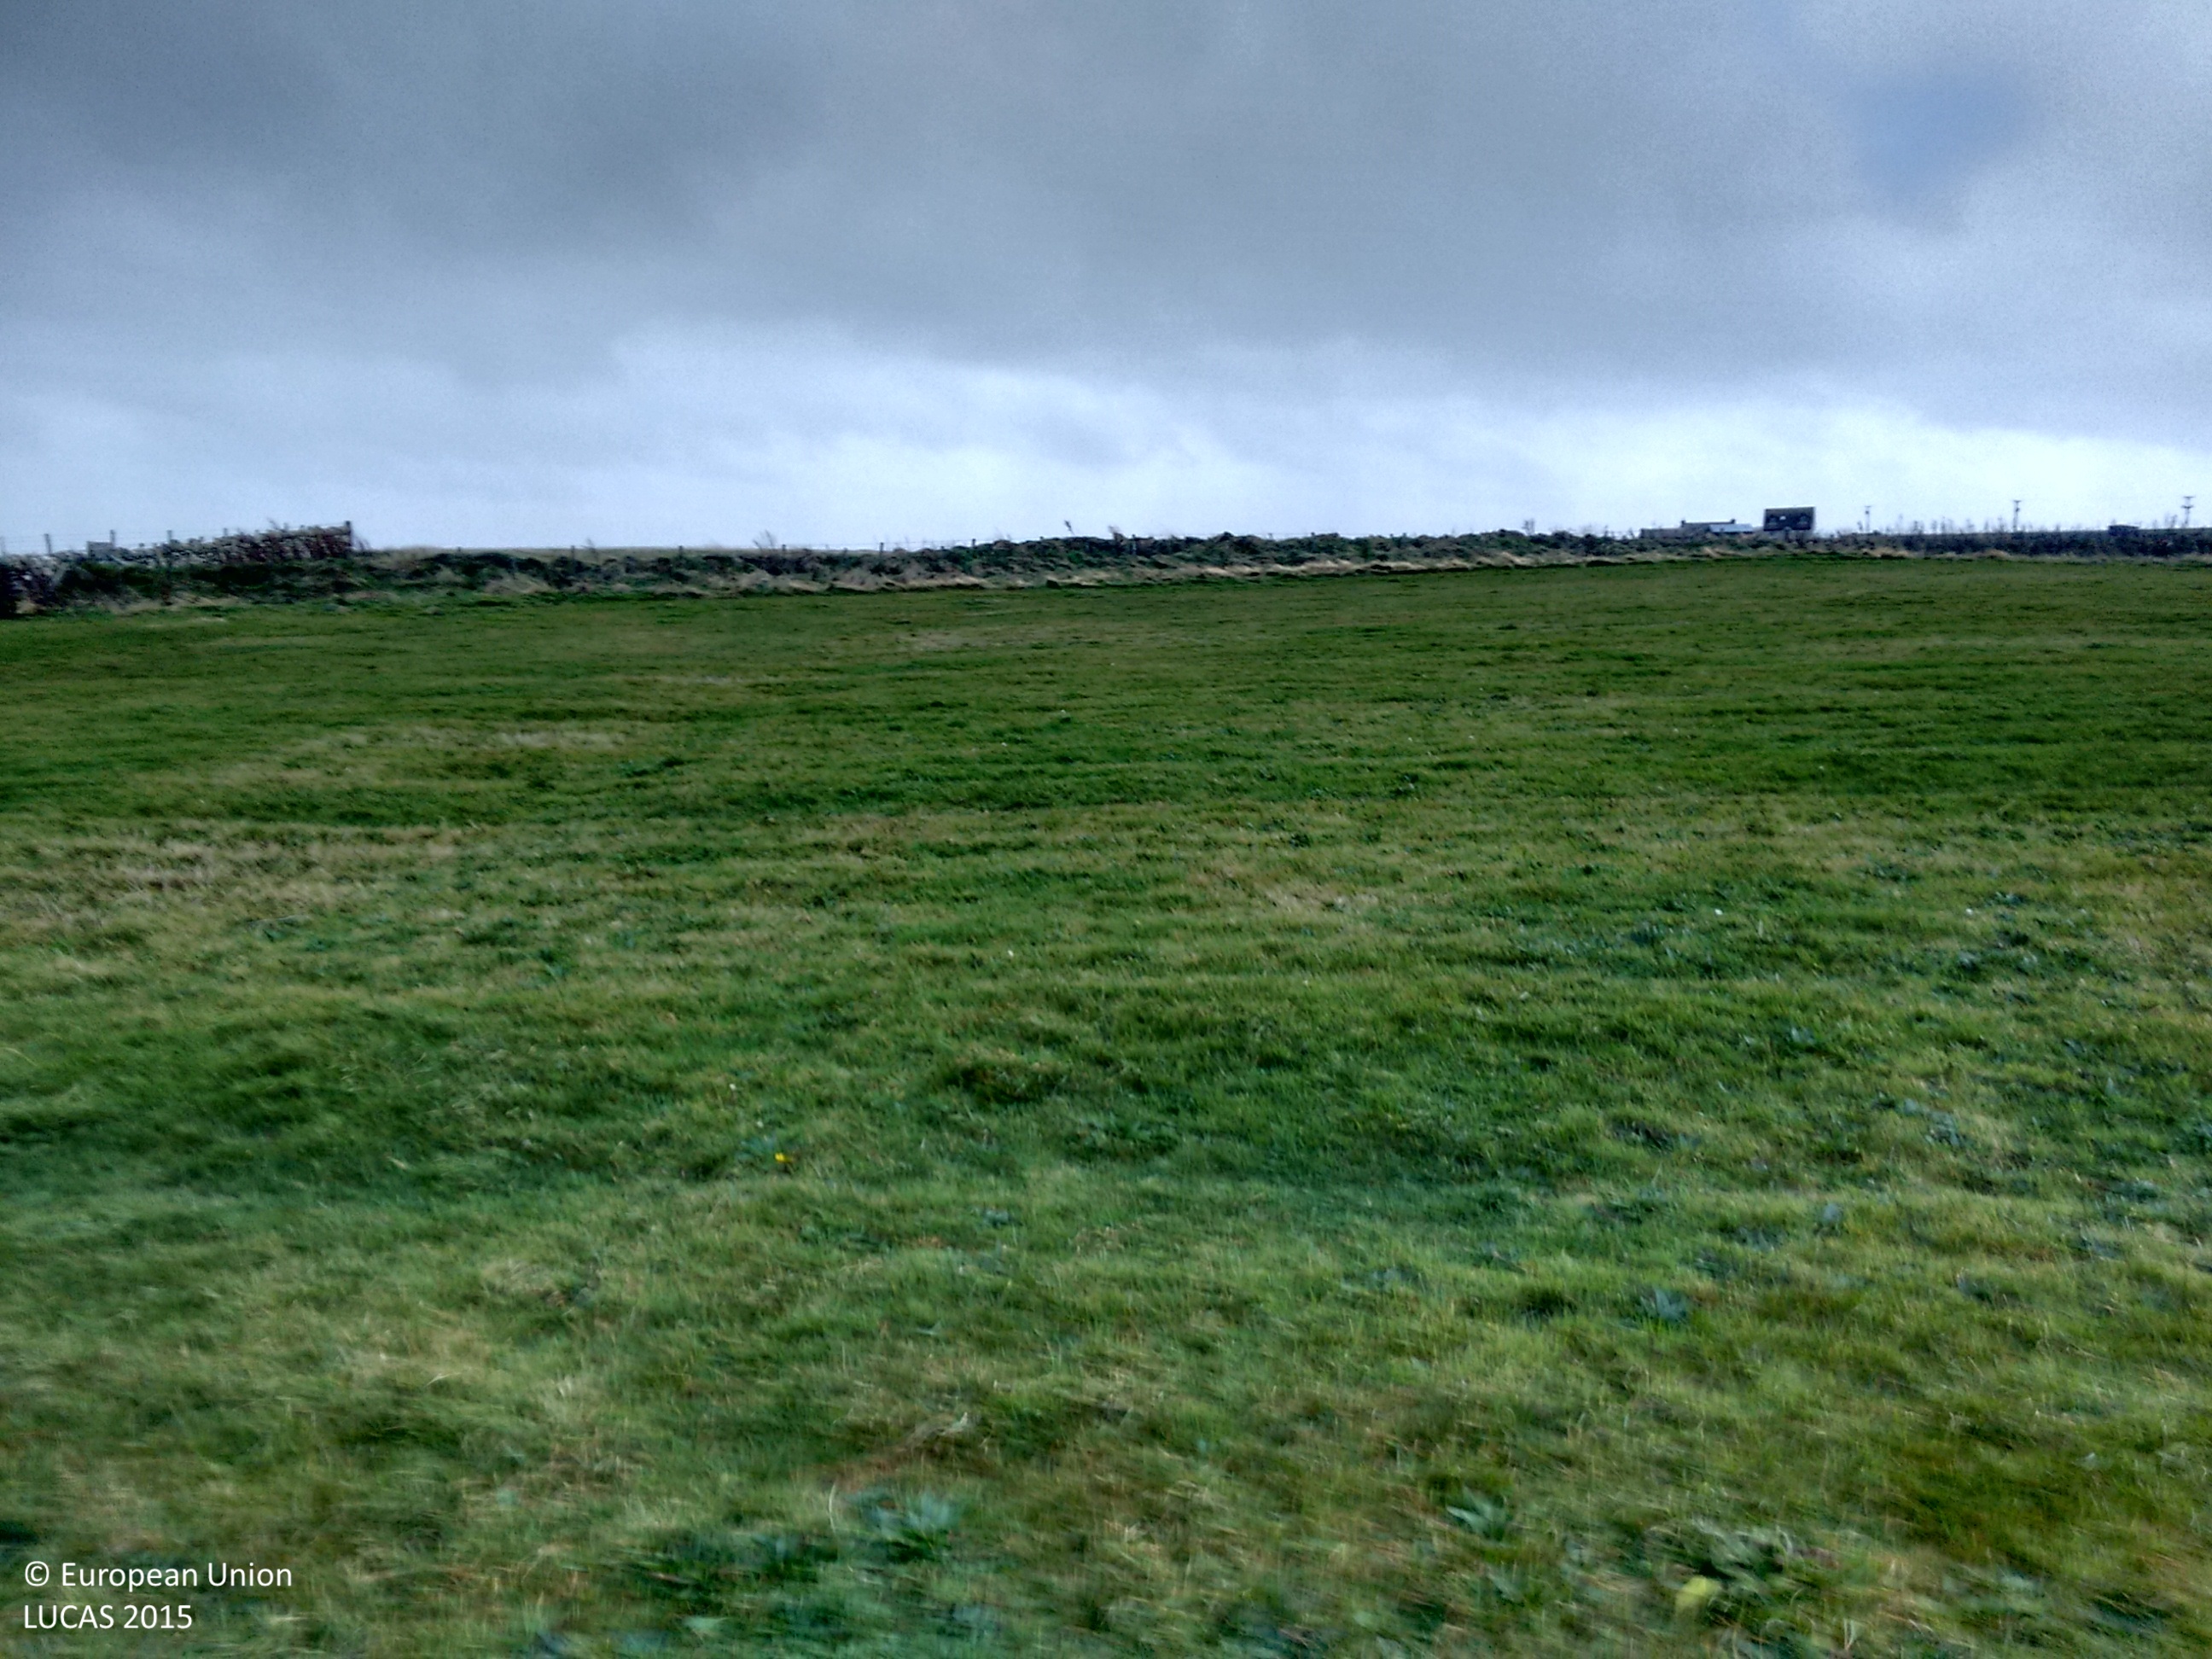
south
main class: Grassland
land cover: Grassland without tree/shrub cover
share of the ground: > 75 %
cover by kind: herbaceous plants 100 %
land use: Agriculture (excluding fallow land and kitchen gardens)
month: November
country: GB
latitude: 58.9493
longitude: -2.8608
